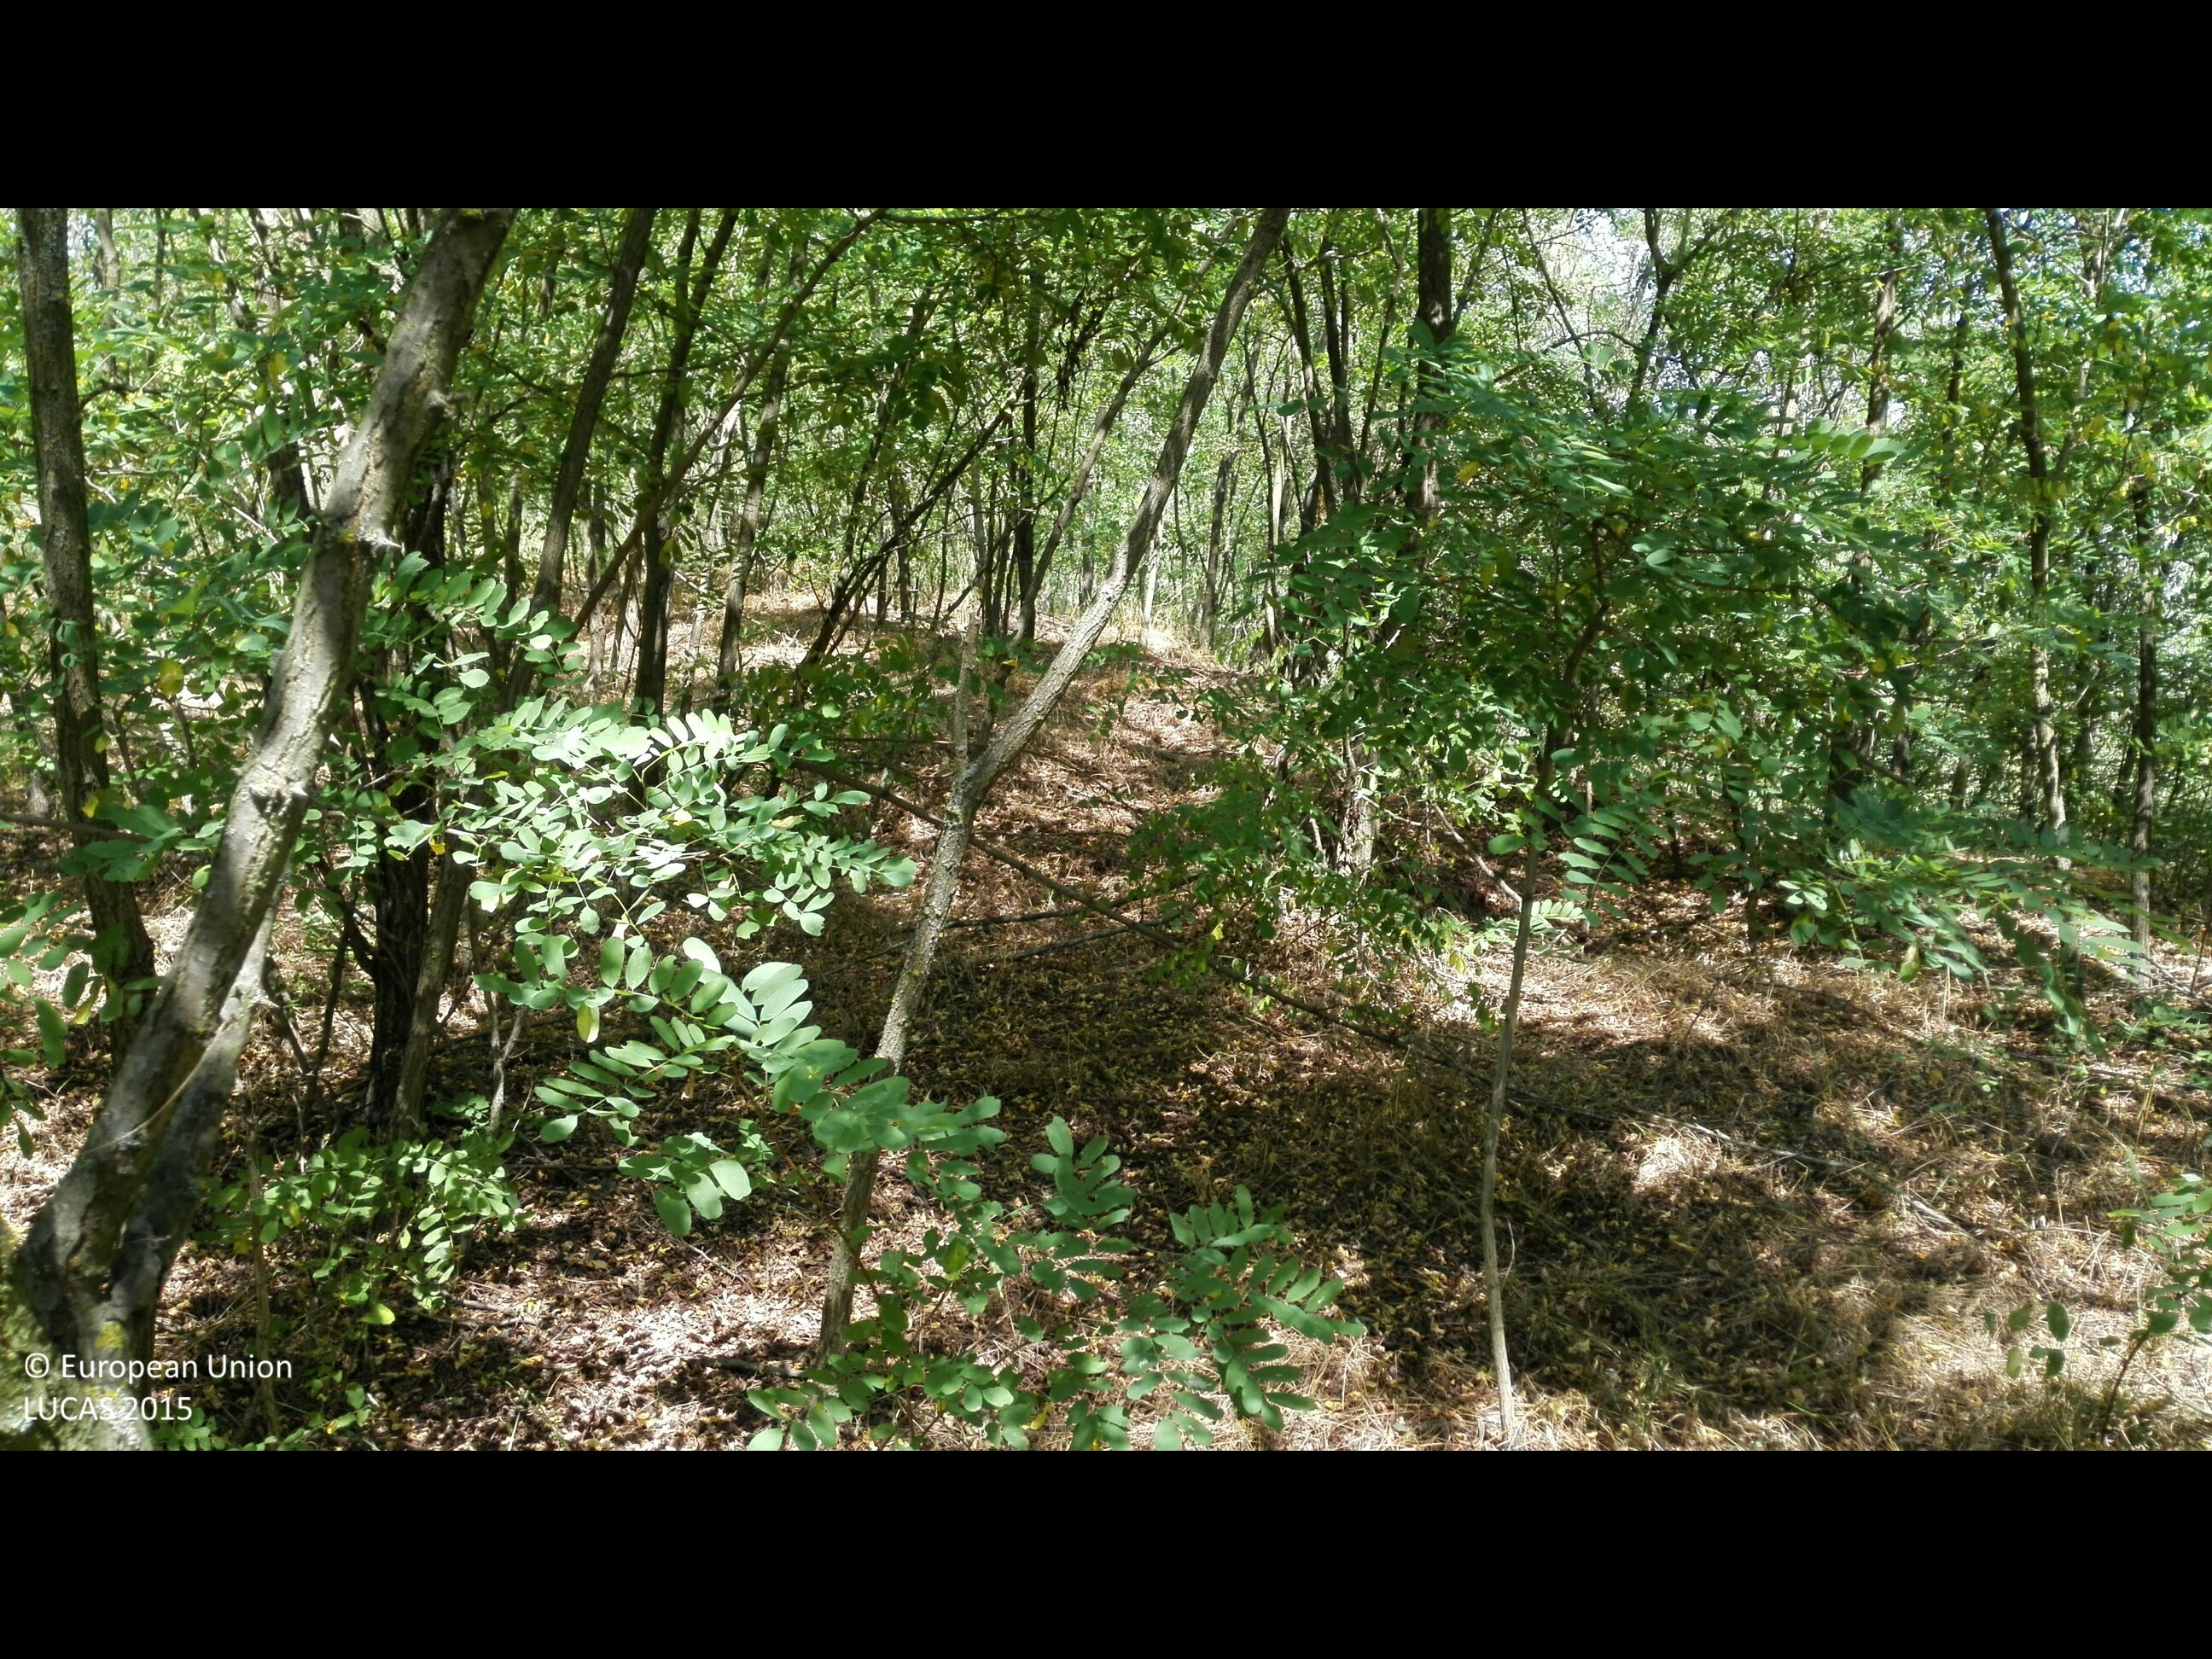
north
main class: Woodland
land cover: Broadleaved woodland
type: exotic forest
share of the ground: > 75 %
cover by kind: broadleaved forest trees 95 %, herbaceous plants 5 %
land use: Forestry
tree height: > 5 m
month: August
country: HU
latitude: 47.4706
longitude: 21.8693
